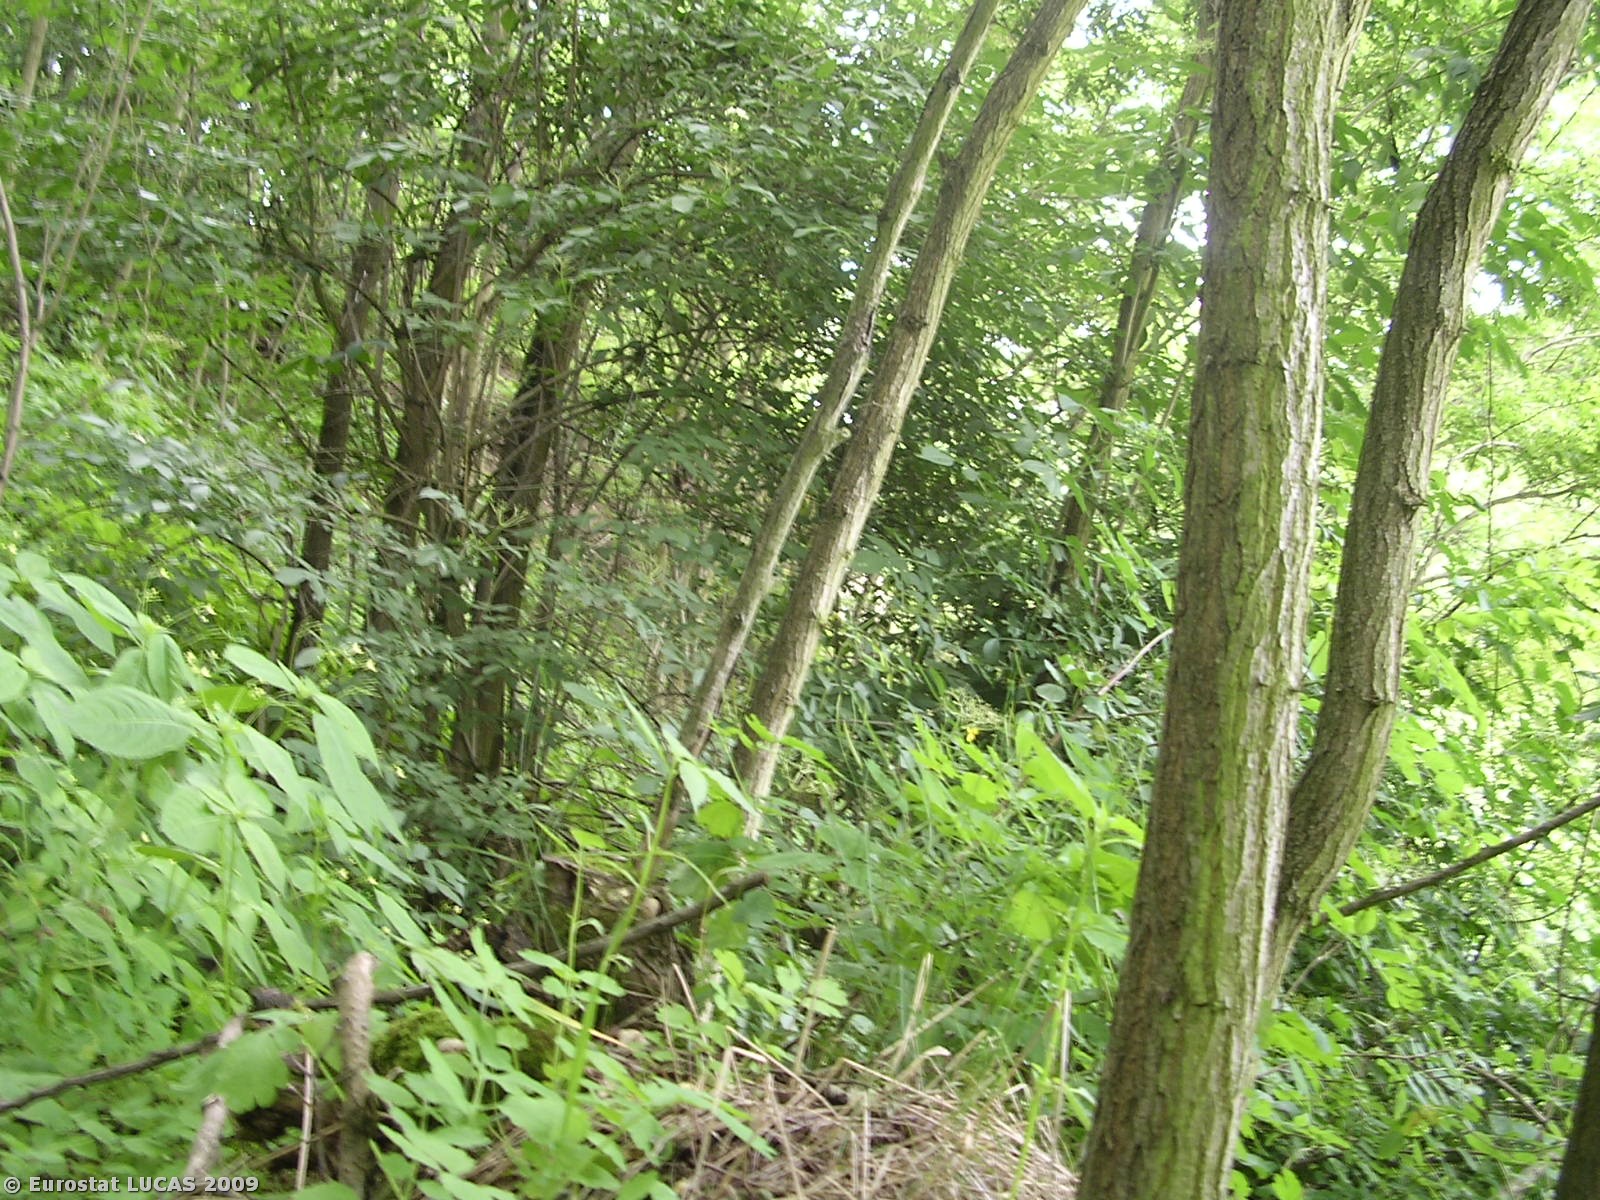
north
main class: Woodland
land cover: Broadleaved woodland
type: plantations and self-sown exotic forest
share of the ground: > 75 %
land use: Unused
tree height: > 5 m
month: June
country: CZ
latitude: 50.5091
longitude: 14.9522
